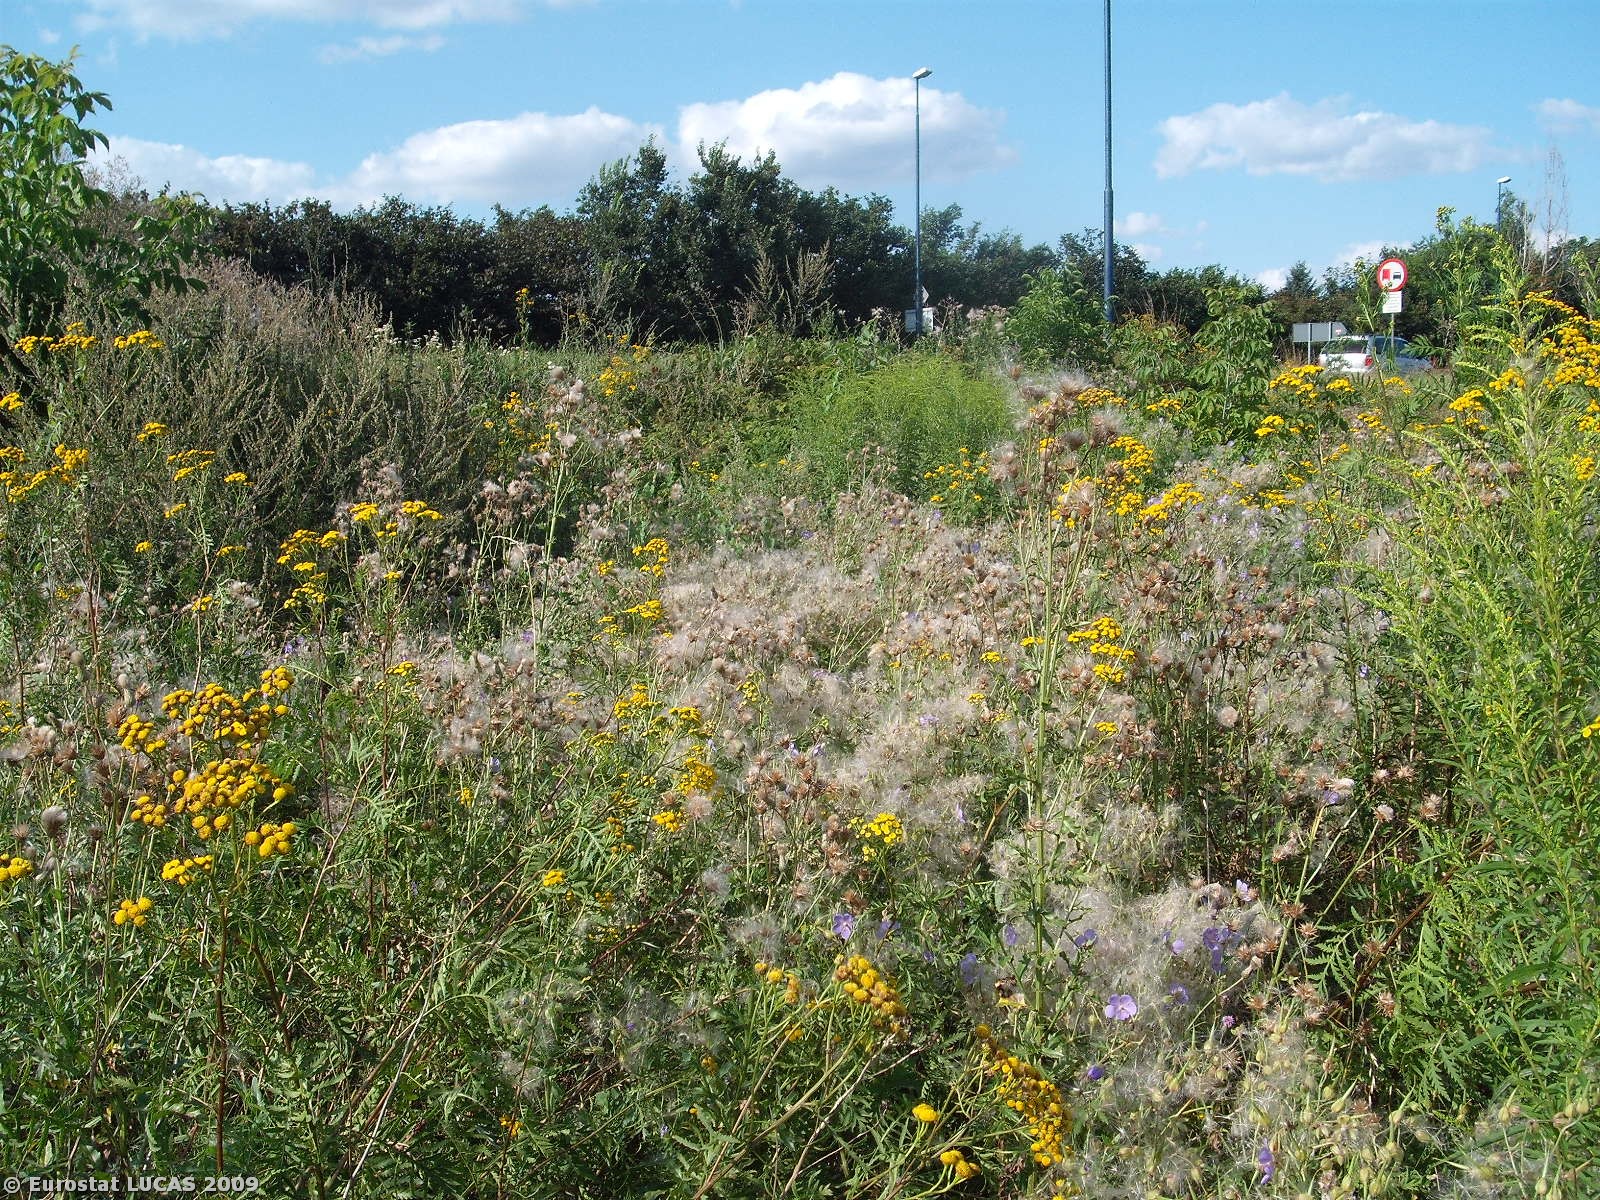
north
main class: Grassland
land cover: Spontaneously vegetated surfaces
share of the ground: > 75 %
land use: Unused
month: August
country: PL
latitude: 50.0525
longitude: 19.9901
